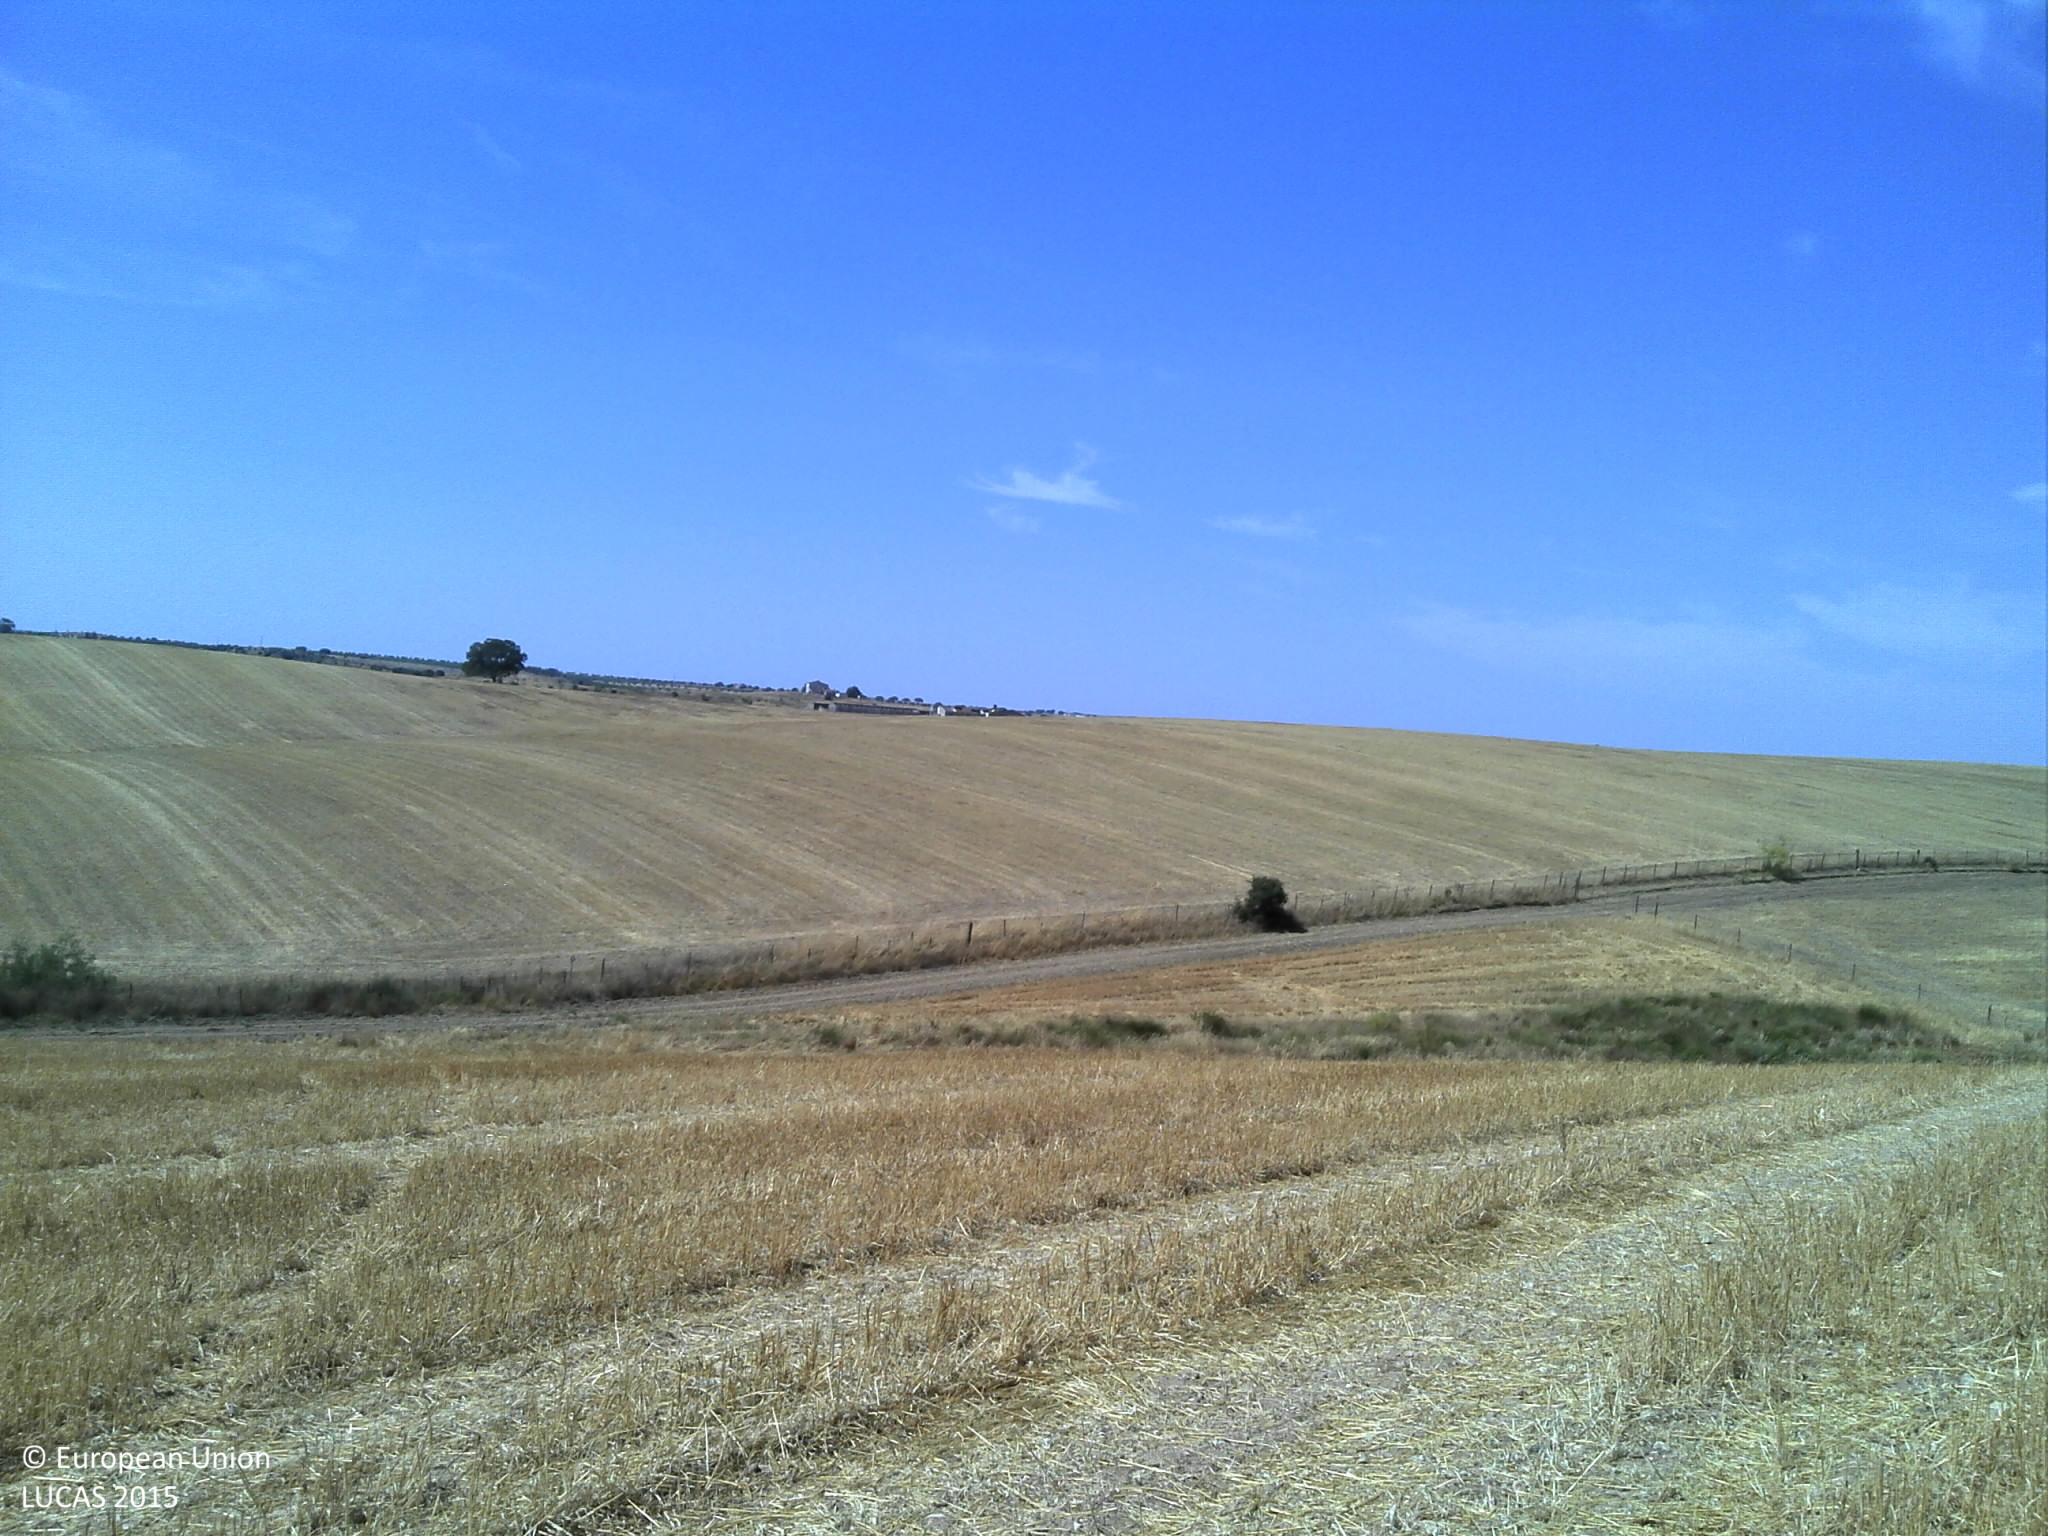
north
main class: Cropland
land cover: Oats
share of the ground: < 10 %
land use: Agriculture (excluding fallow land and kitchen gardens)
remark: Harvested field
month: July
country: PT
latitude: 38.4115
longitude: -7.6557
